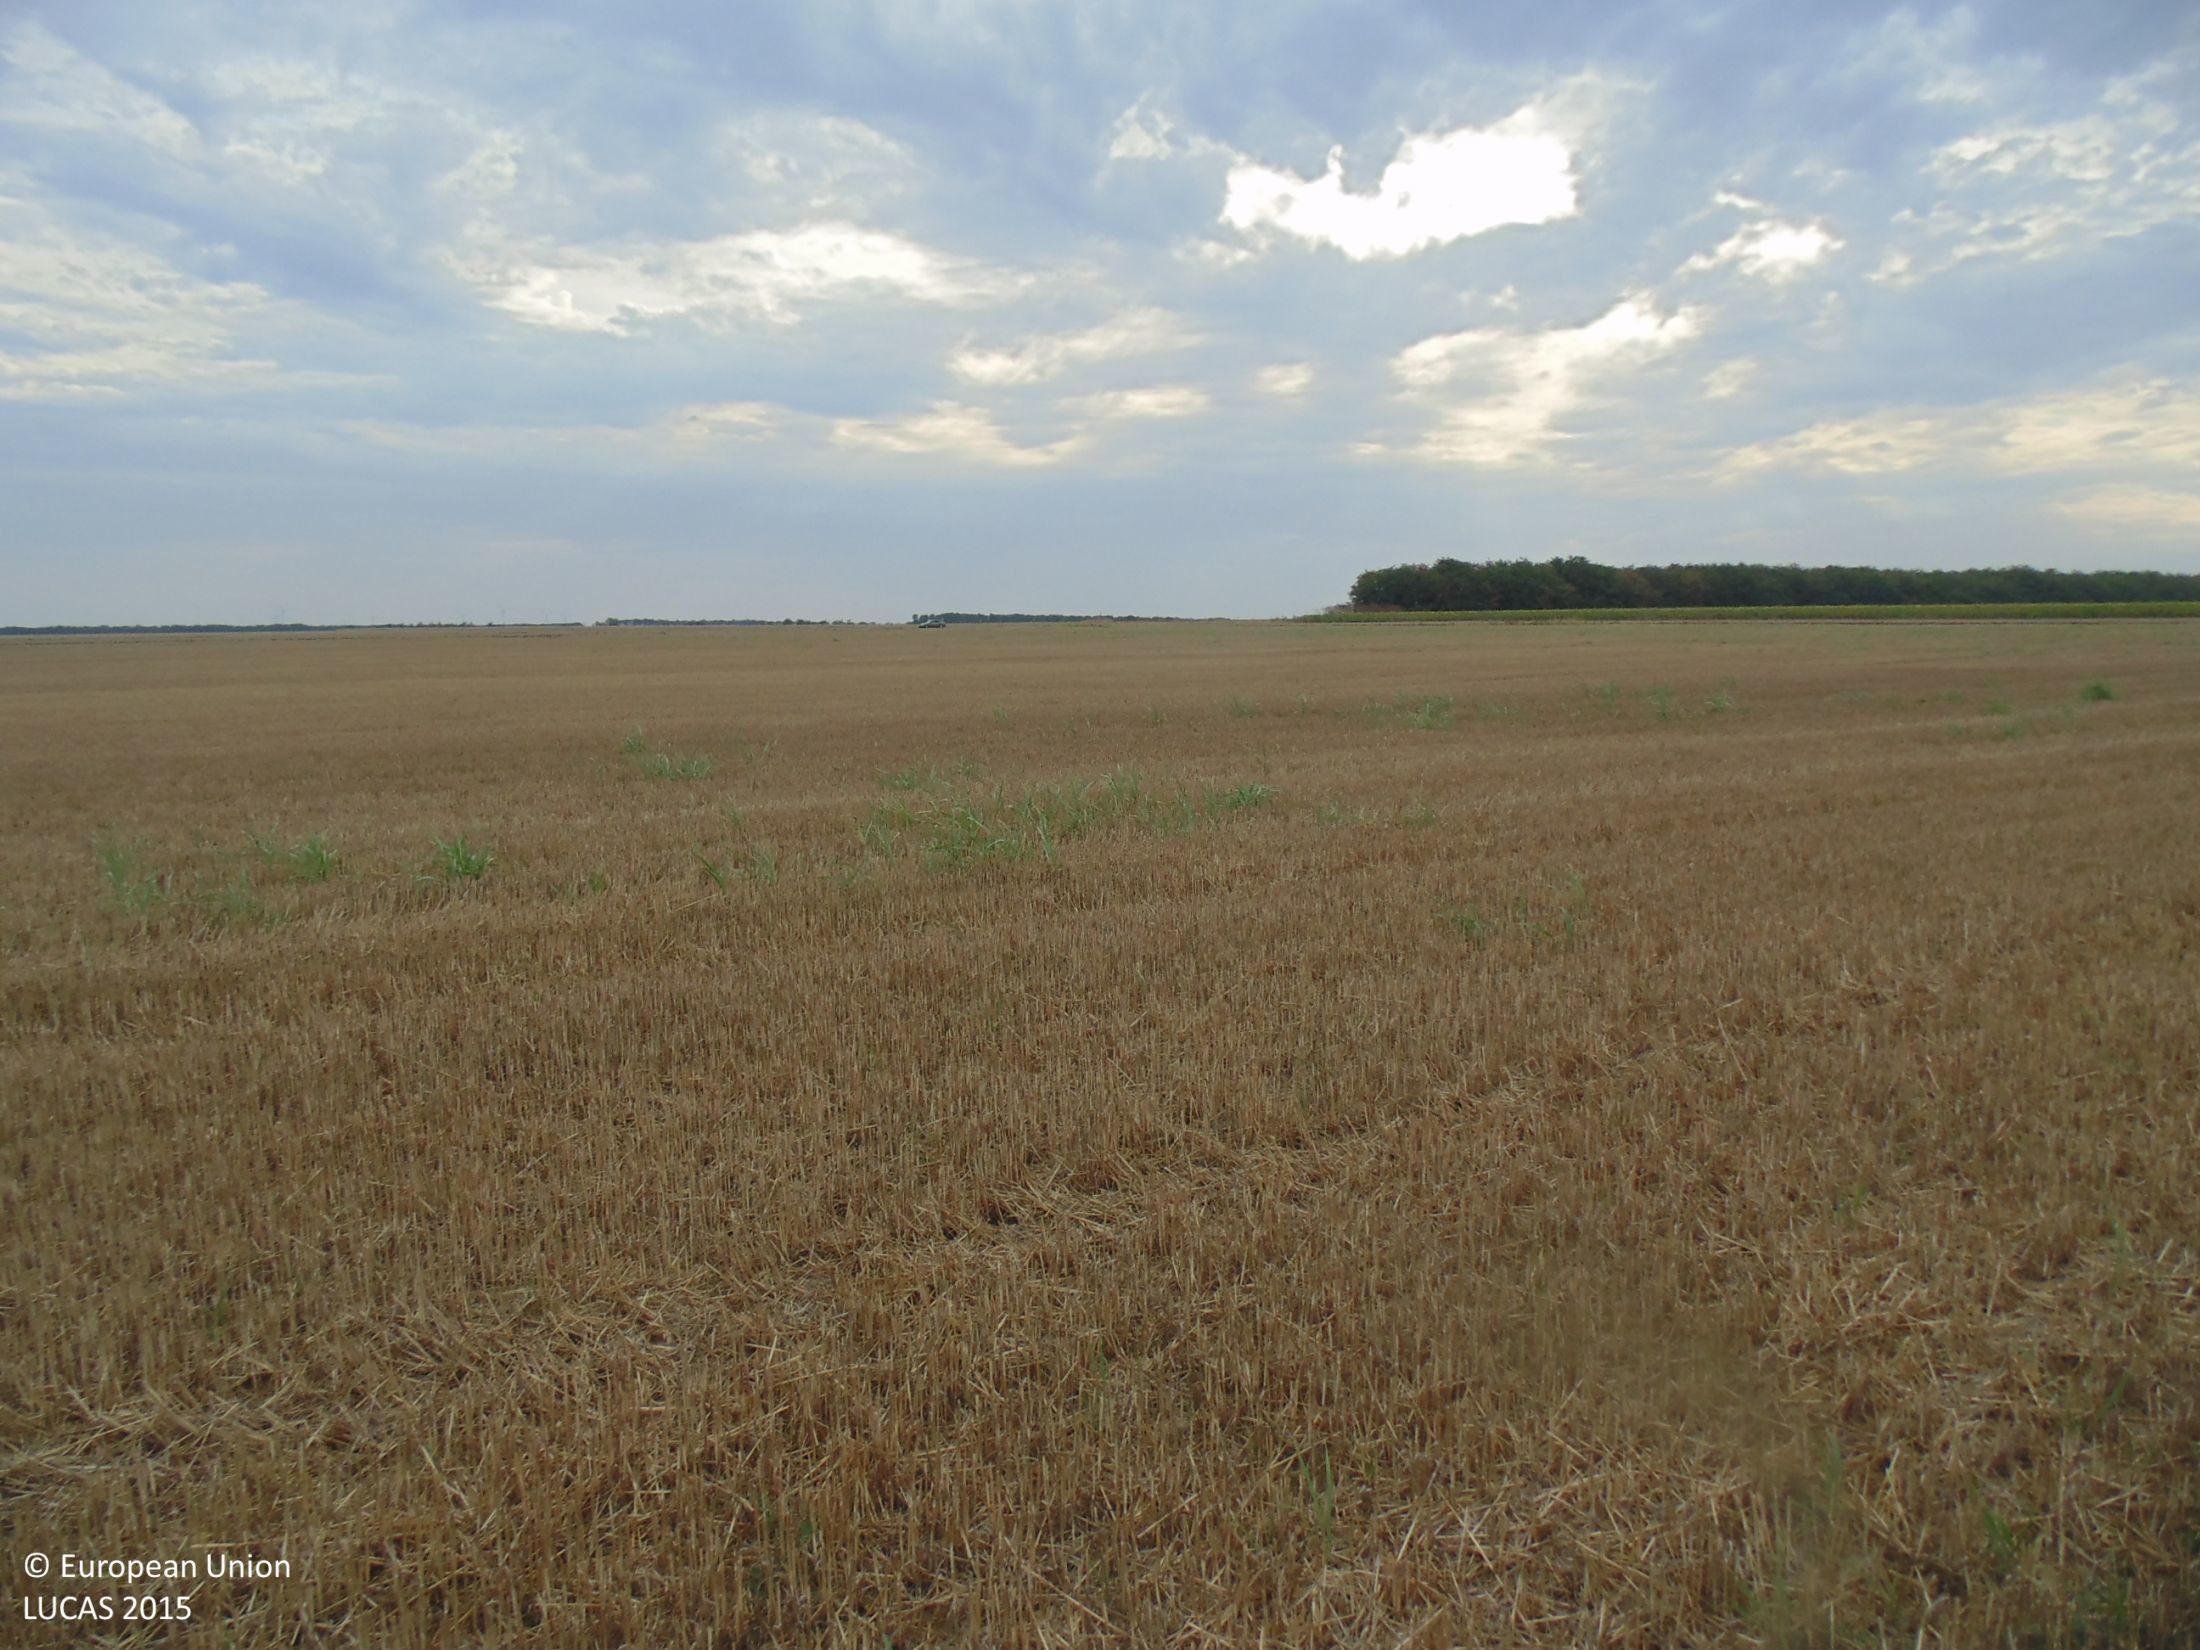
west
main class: Cropland
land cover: Common wheat
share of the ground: 50 - 75 %
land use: Agriculture (excluding fallow land and kitchen gardens)
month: August
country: BG
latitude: 43.5084
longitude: 28.5559
